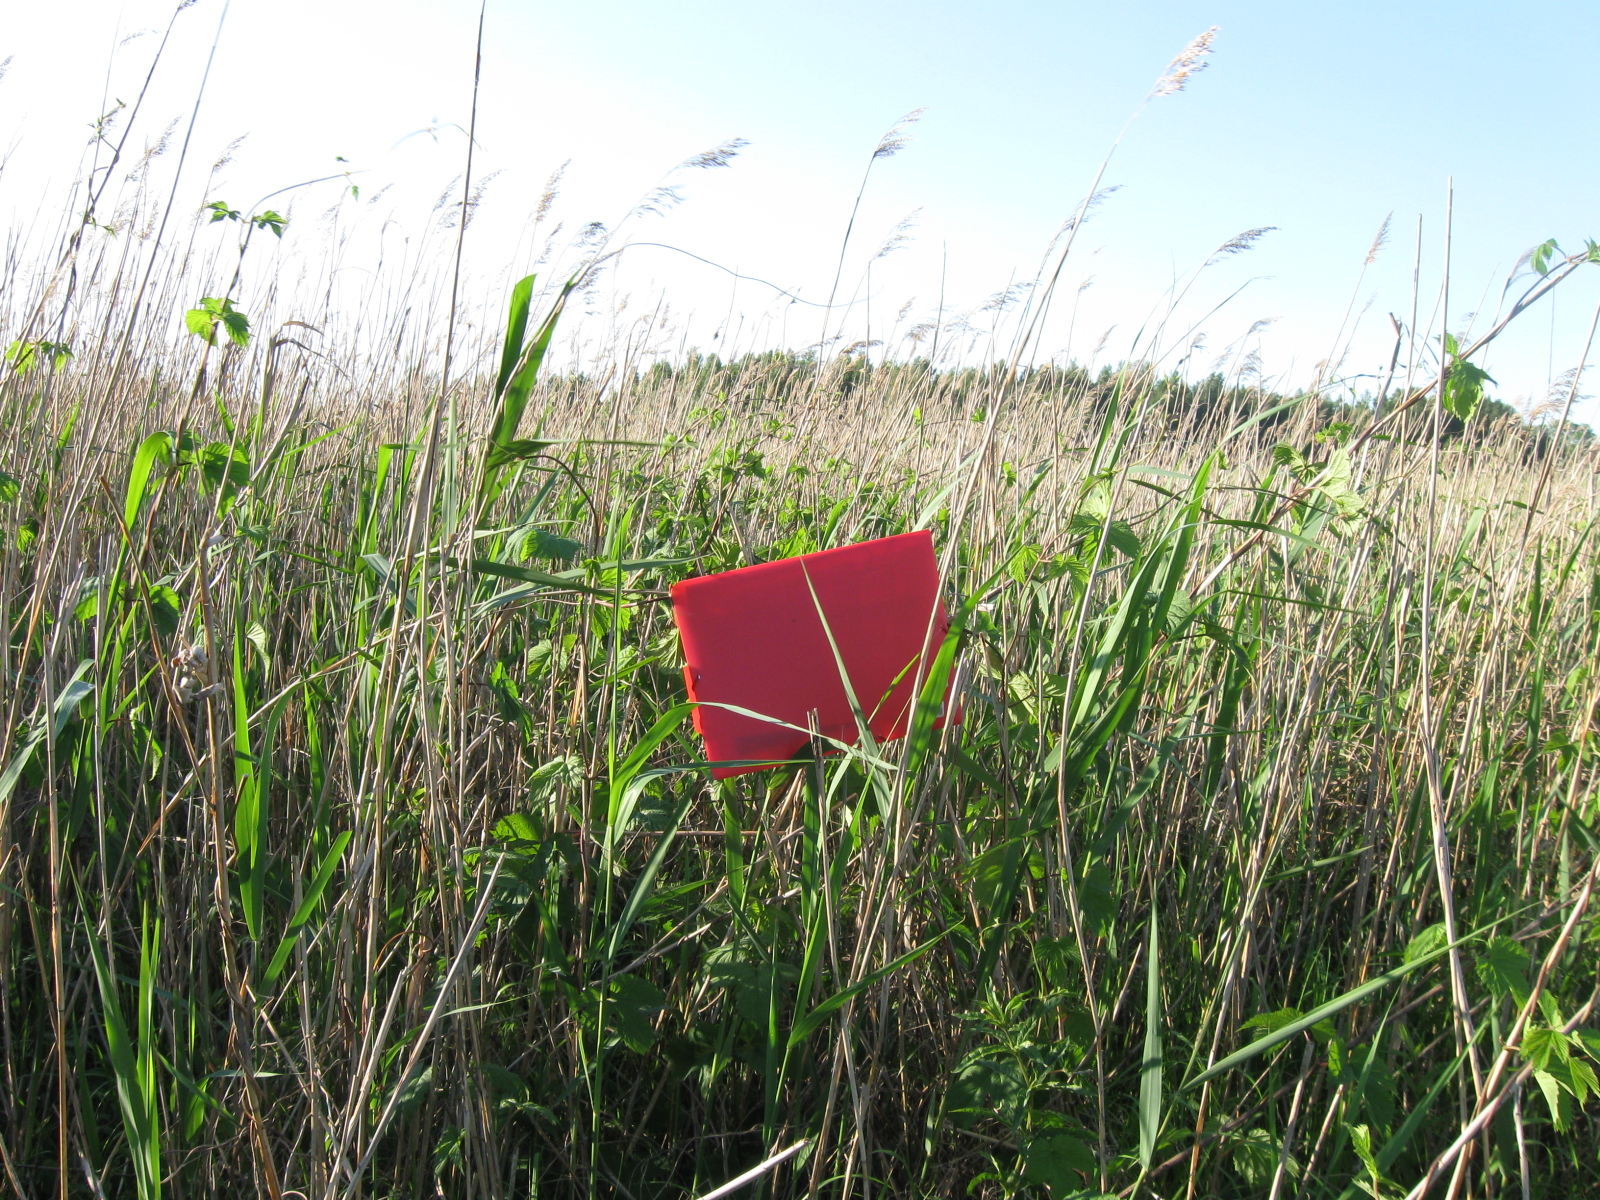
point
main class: Grassland
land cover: Spontaneously vegetated surfaces
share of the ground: > 75 %
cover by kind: herbaceous plants 100 %
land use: Semi-natural and natural areas not in use
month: June
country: LT
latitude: 54.4265
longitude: 23.8536
